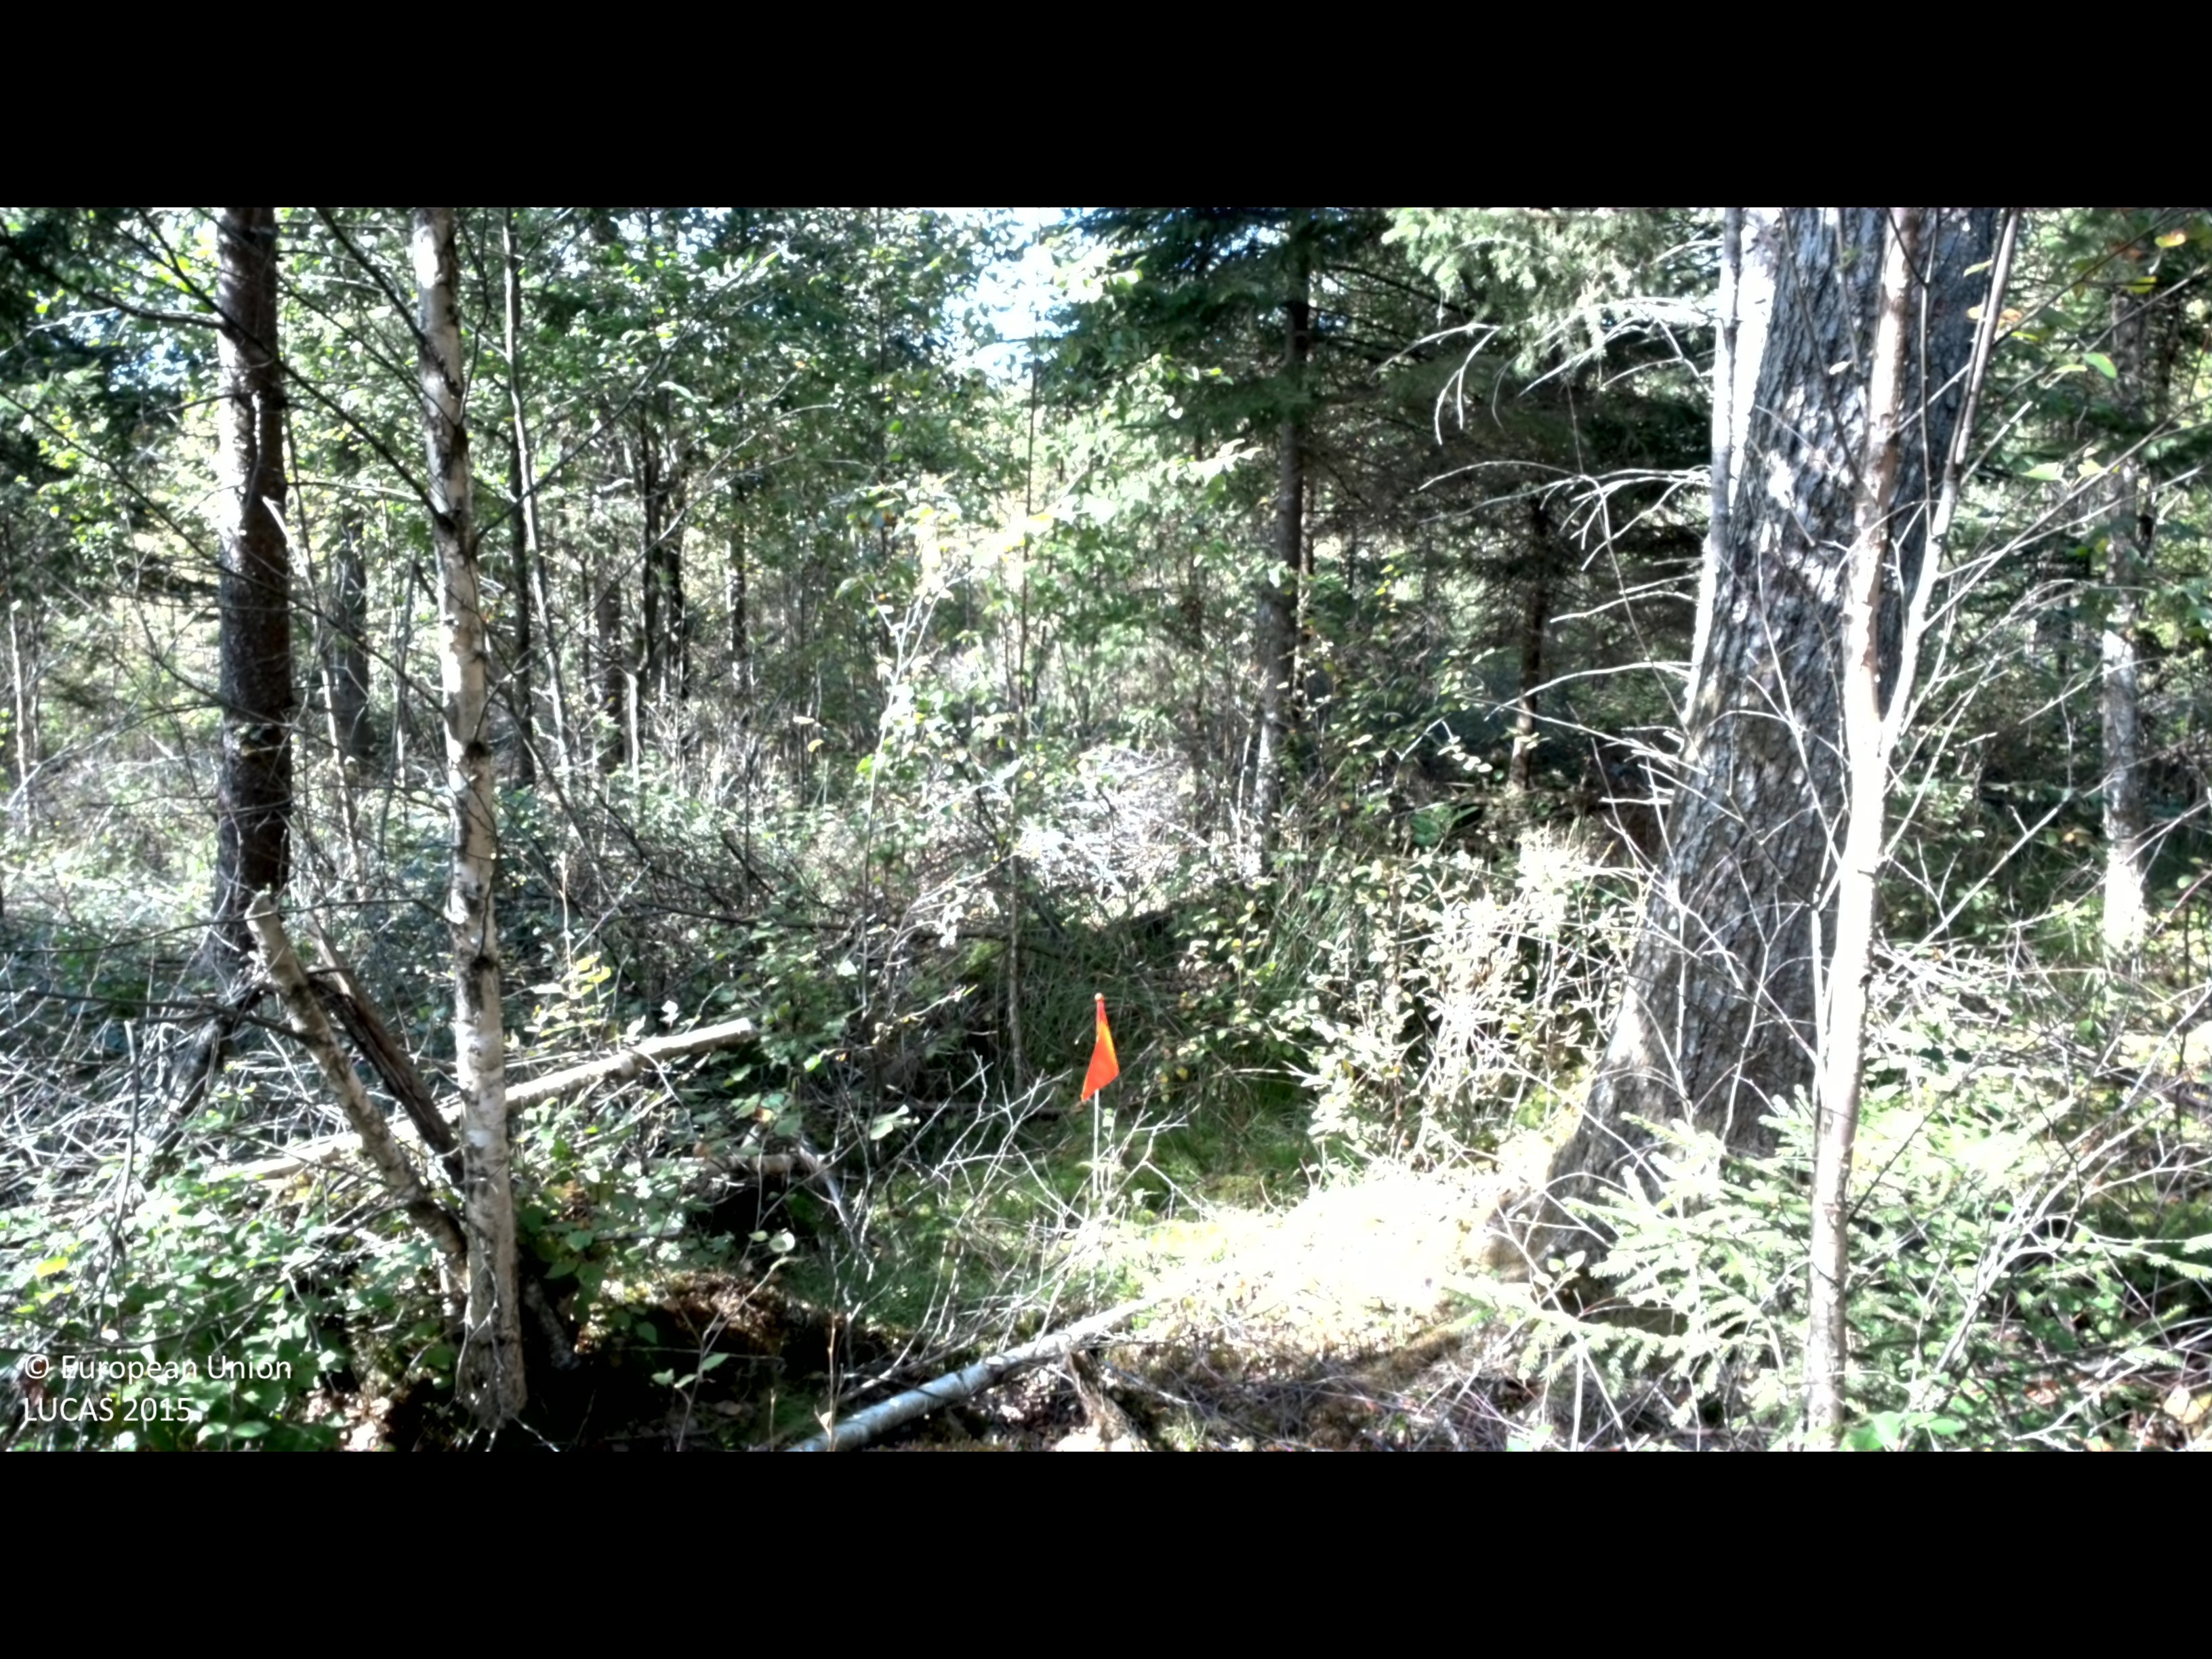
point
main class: Woodland
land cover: Spruce dominated mixed woodland
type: boreal forest
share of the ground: > 75 %
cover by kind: broadleaved forest trees 45 %, coniferous forest trees 35 %, shrubs 10 %, herbaceous plants 5 %, lichens and mosses 5 %
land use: Forestry
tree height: > 5 m
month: September
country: SE
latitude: 57.0130
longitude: 13.1418
